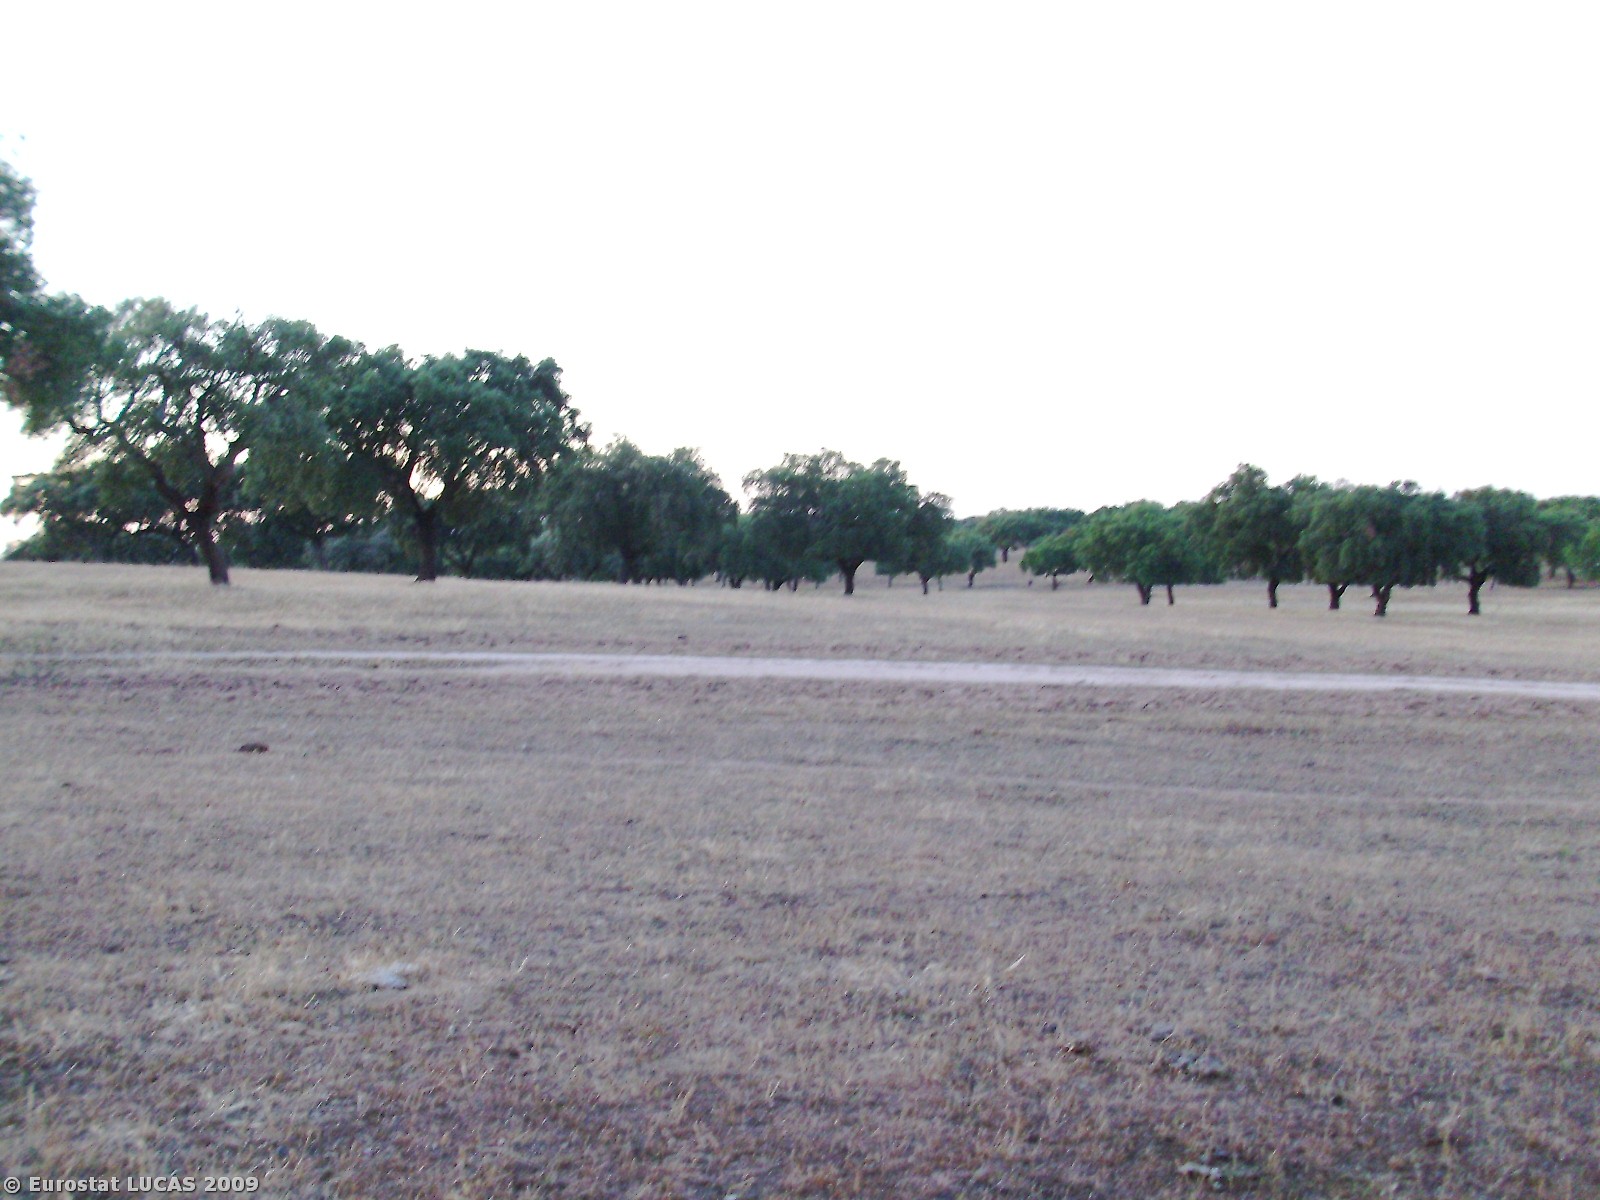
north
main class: Grassland
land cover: Grassland with sparse tree/shrub cover
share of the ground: > 75 %
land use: Agriculture (excluding fallow land and kitchen gardens)
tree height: > 5 m
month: May
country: PT
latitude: 38.9518
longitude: -7.3297
